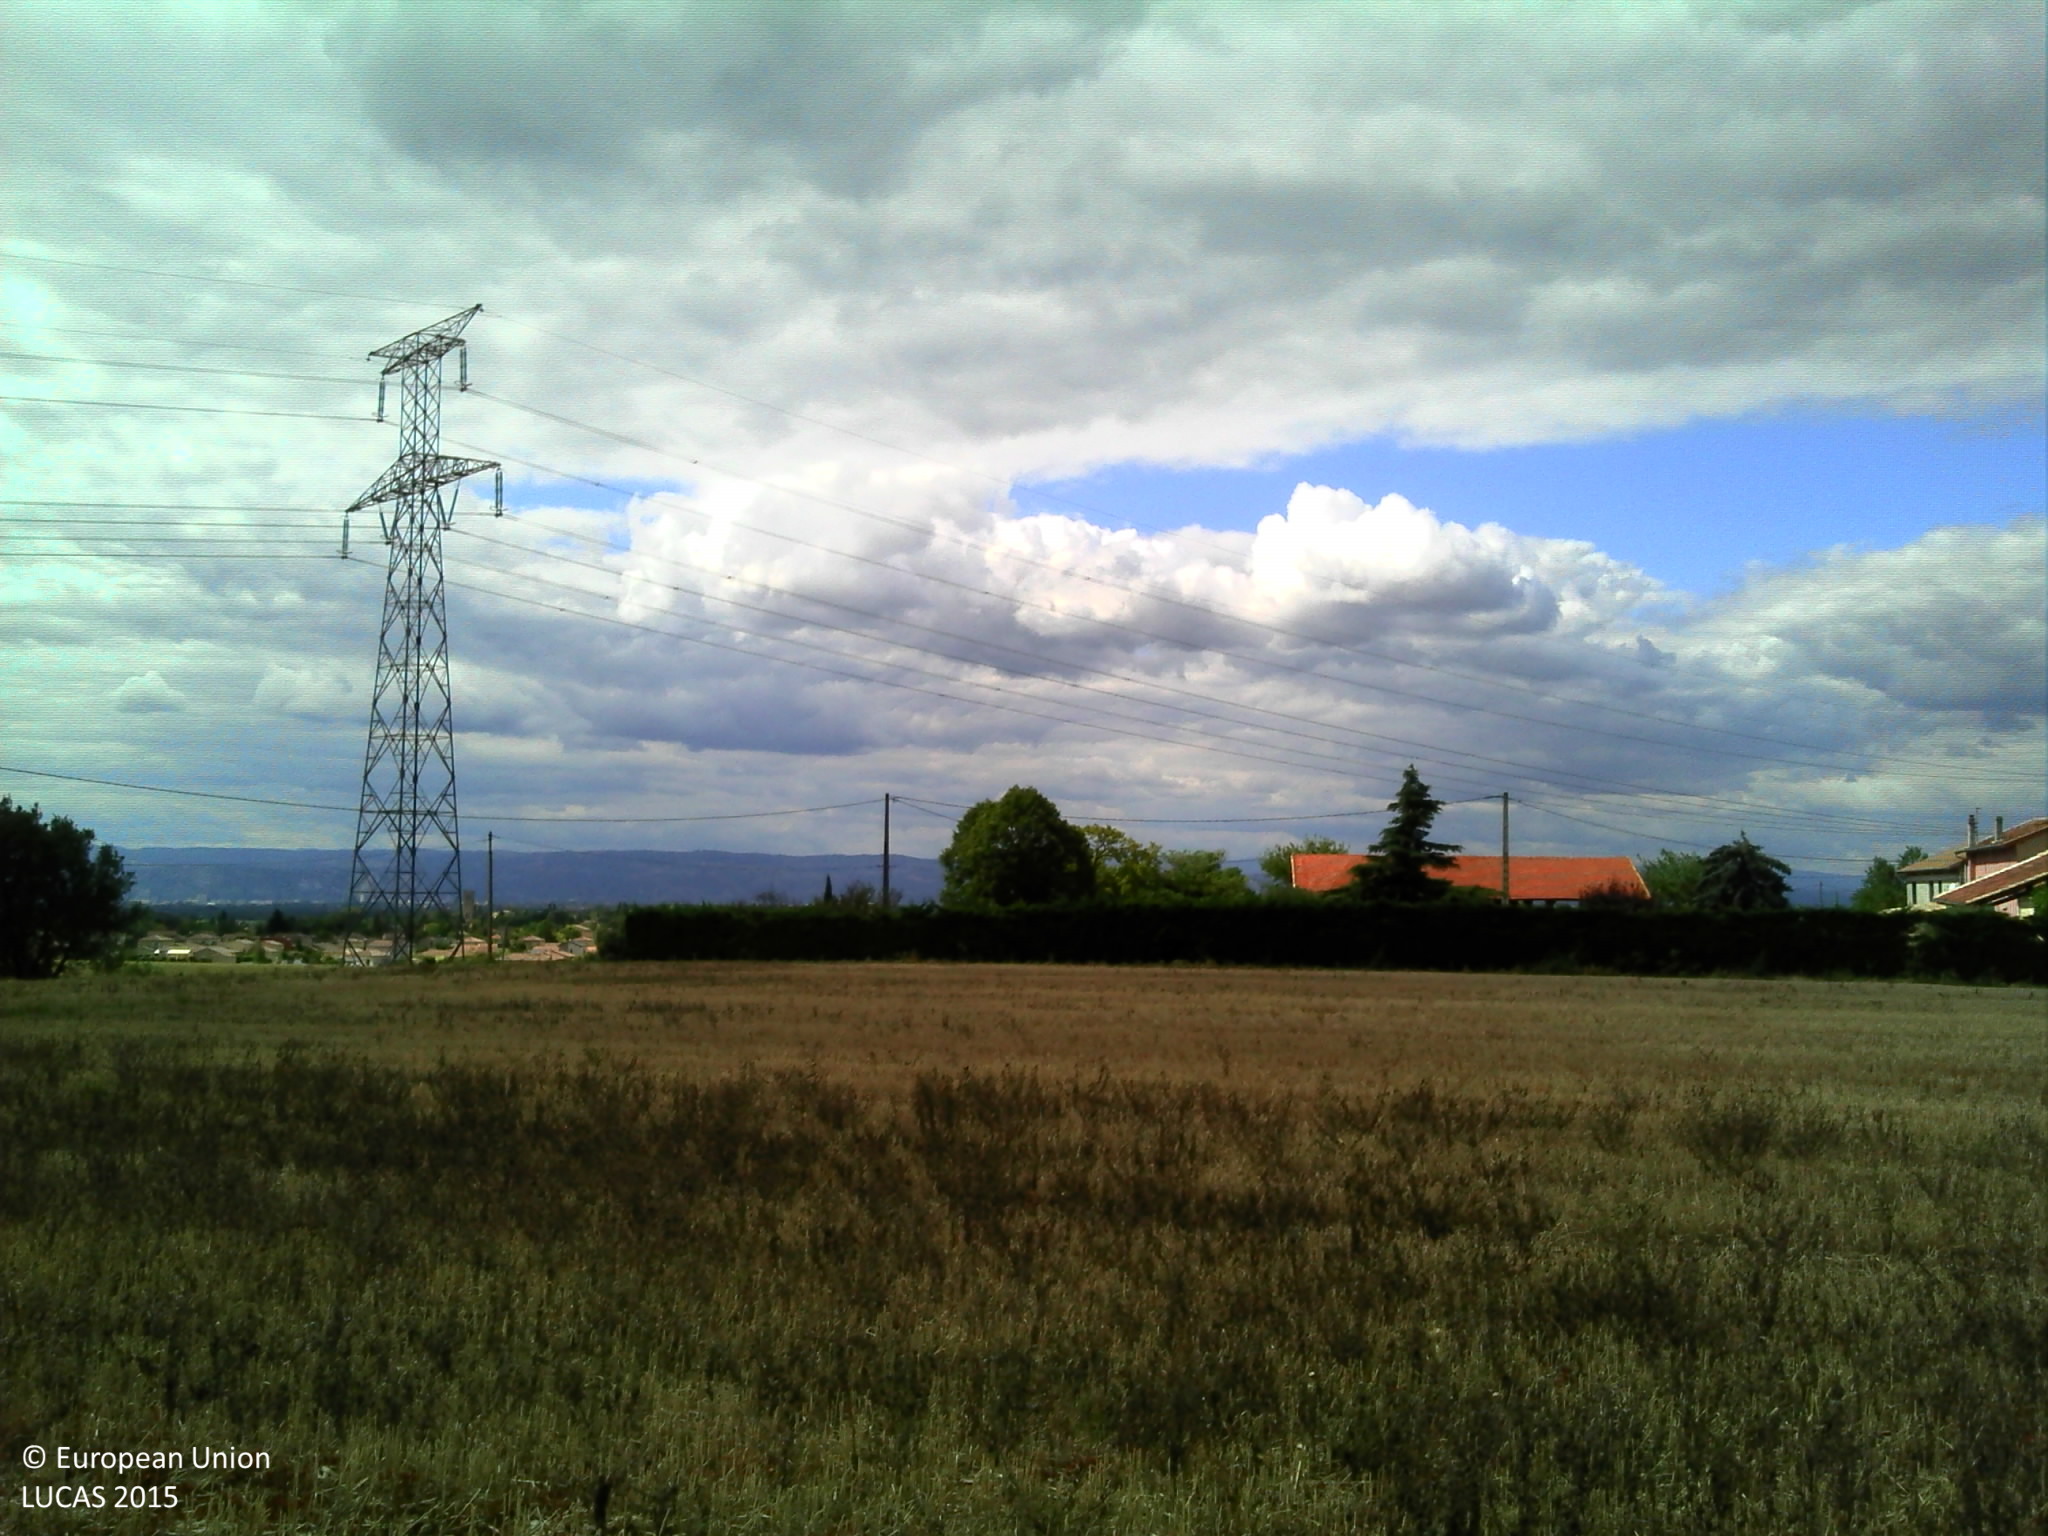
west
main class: Cropland
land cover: Common wheat
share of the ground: > 75 %
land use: Agriculture (excluding fallow land and kitchen gardens)
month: September
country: FR
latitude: 44.9370
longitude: 5.0511
